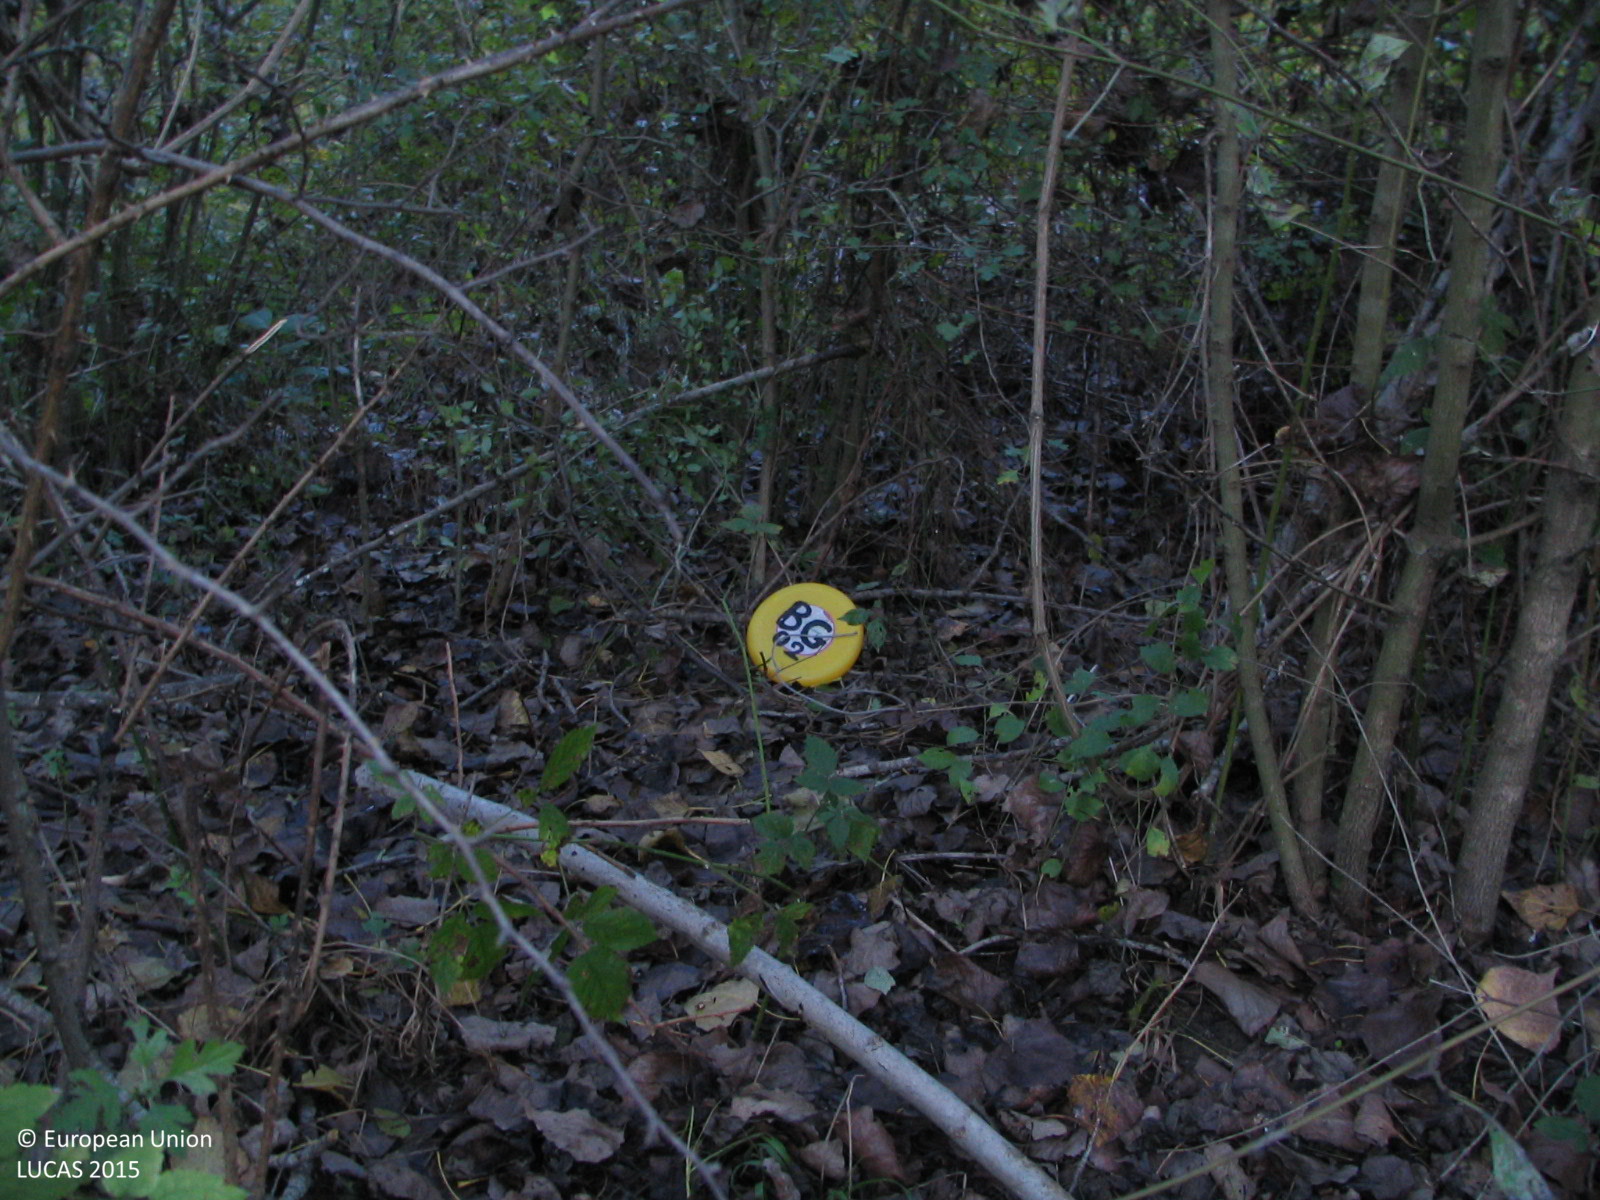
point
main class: Woodland
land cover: Broadleaved woodland
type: mesophytic deciduous forest
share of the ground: > 75 %
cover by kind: broadleaved forest trees 95 %, shrubs 5 %
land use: Semi-natural and natural areas not in use
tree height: > 5 m
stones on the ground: < 10 %
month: October
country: BG
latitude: 43.0998
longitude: 23.8941
